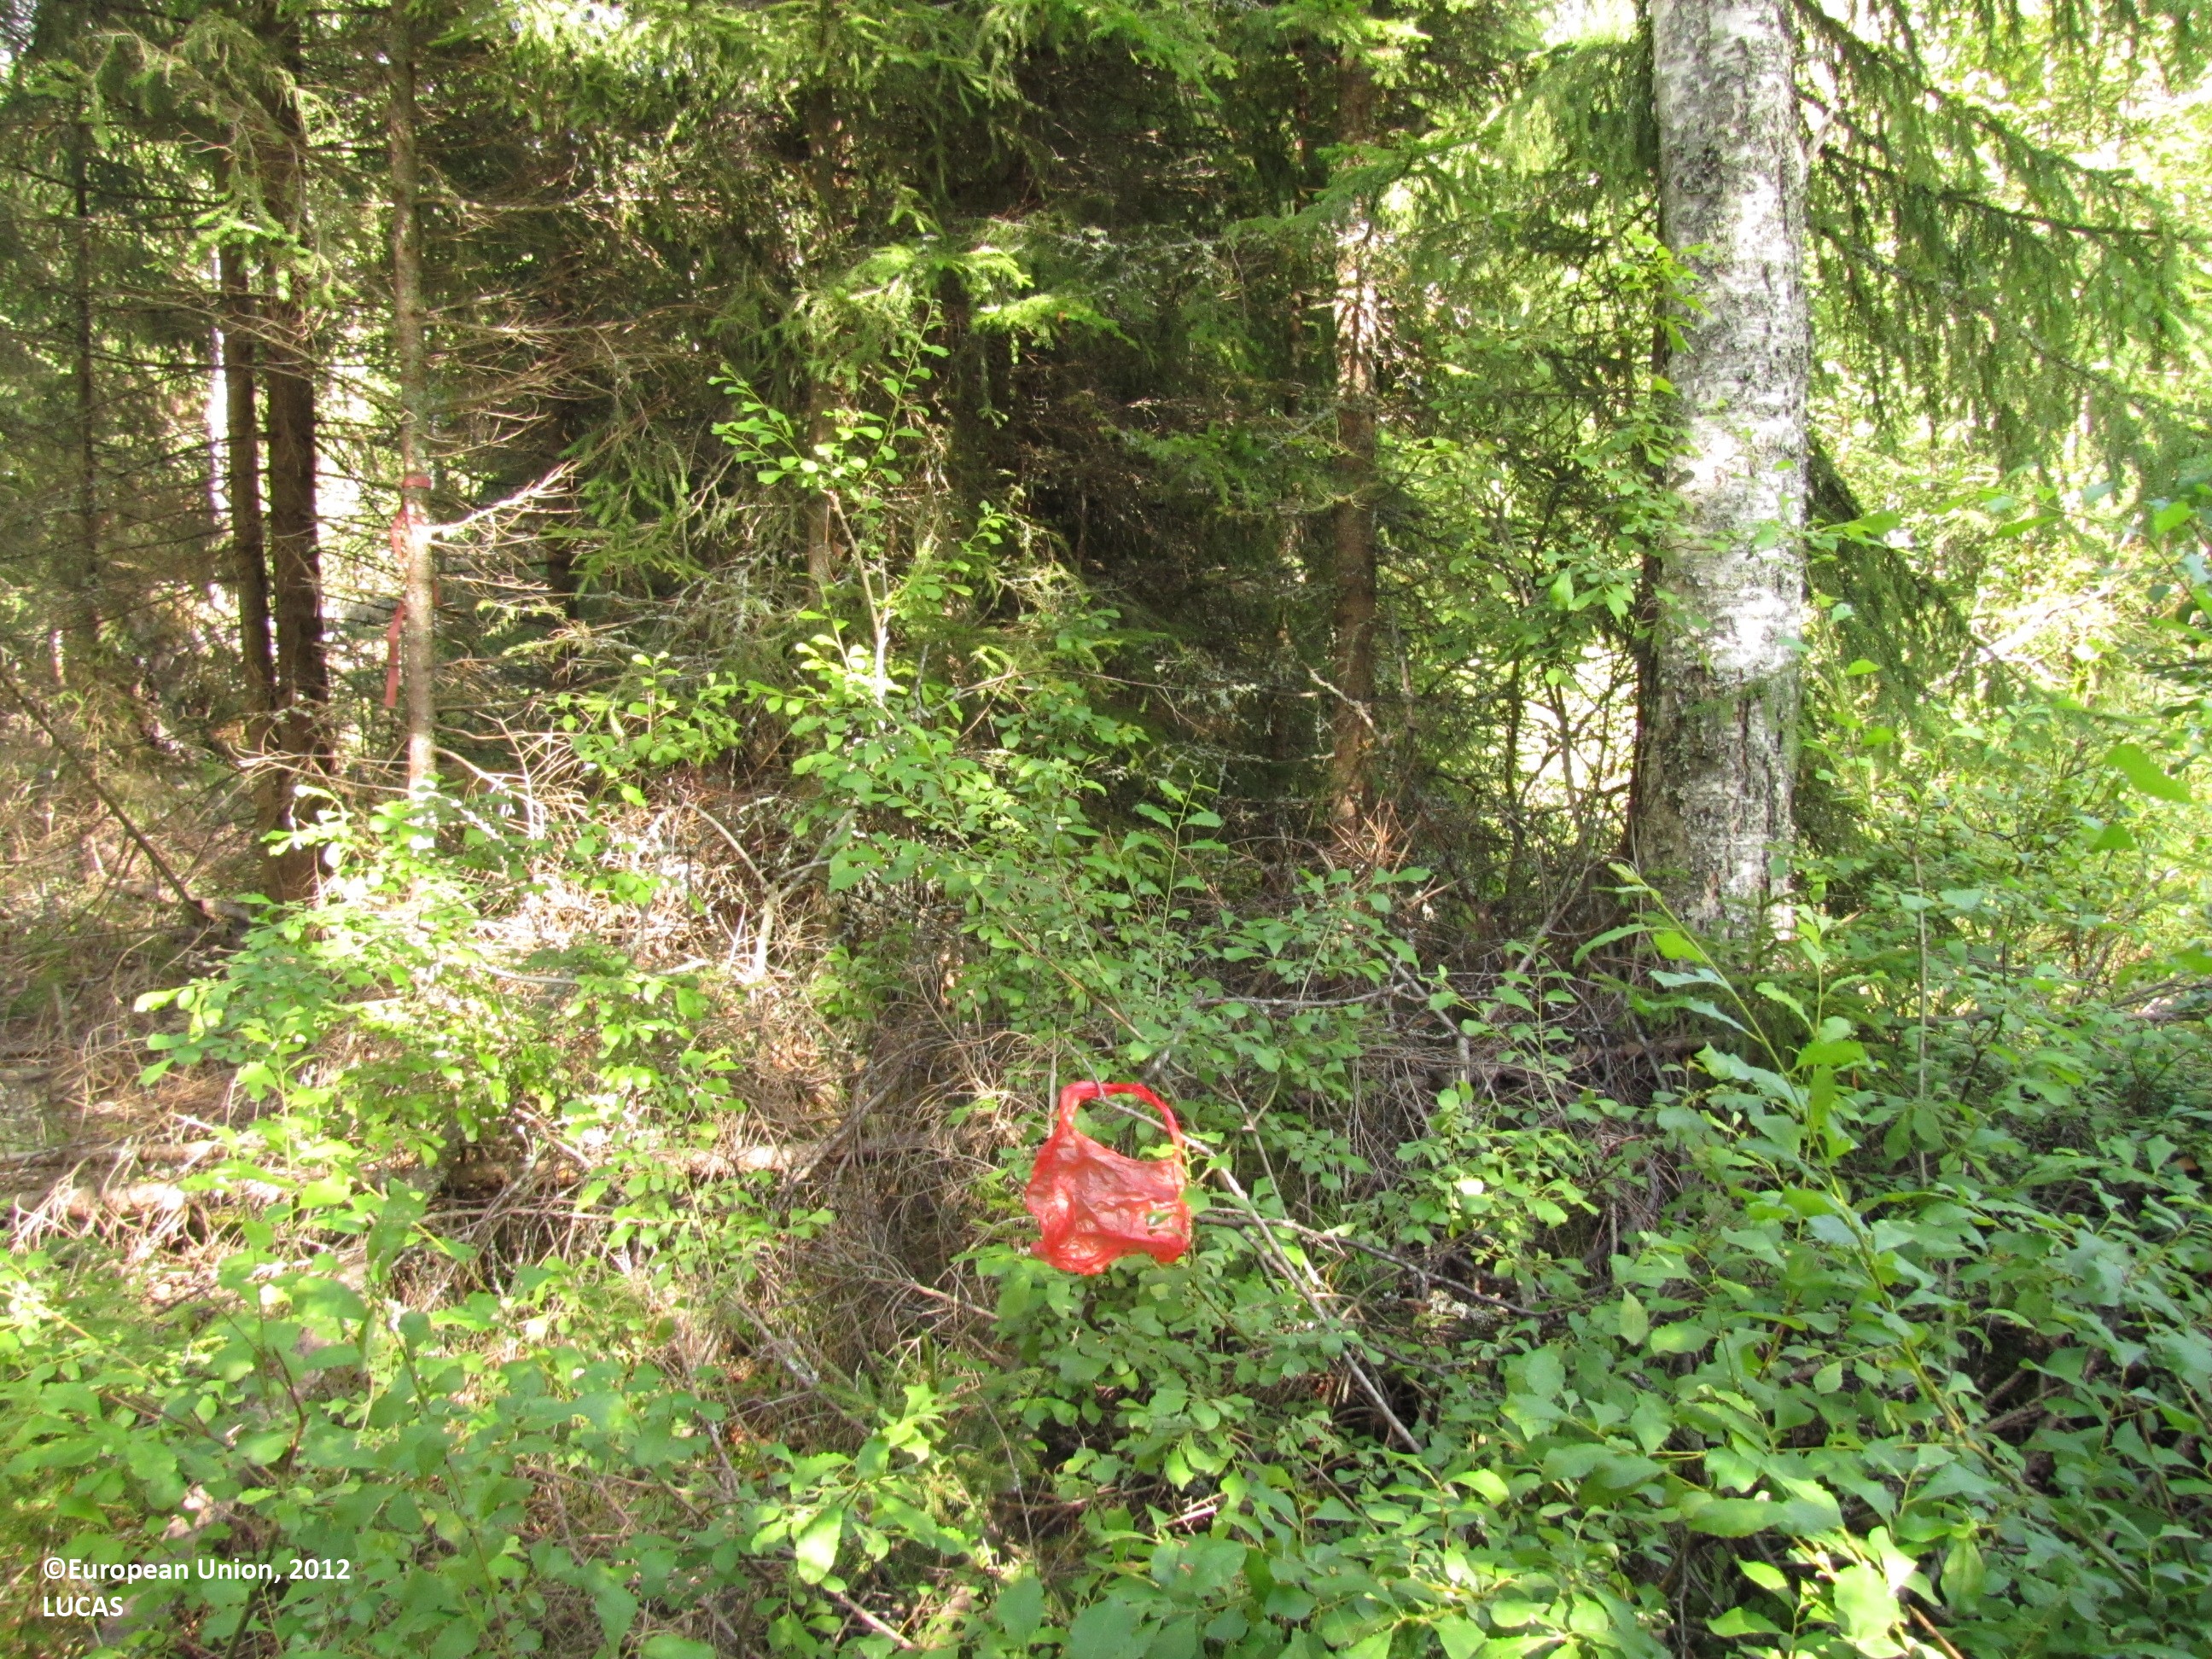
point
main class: Woodland
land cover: Spruce dominated mixed woodland
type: boreal forest
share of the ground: 50 - 75 %
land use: Forestry
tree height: > 5 m
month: August
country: FI
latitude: 61.7622
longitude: 22.8940
